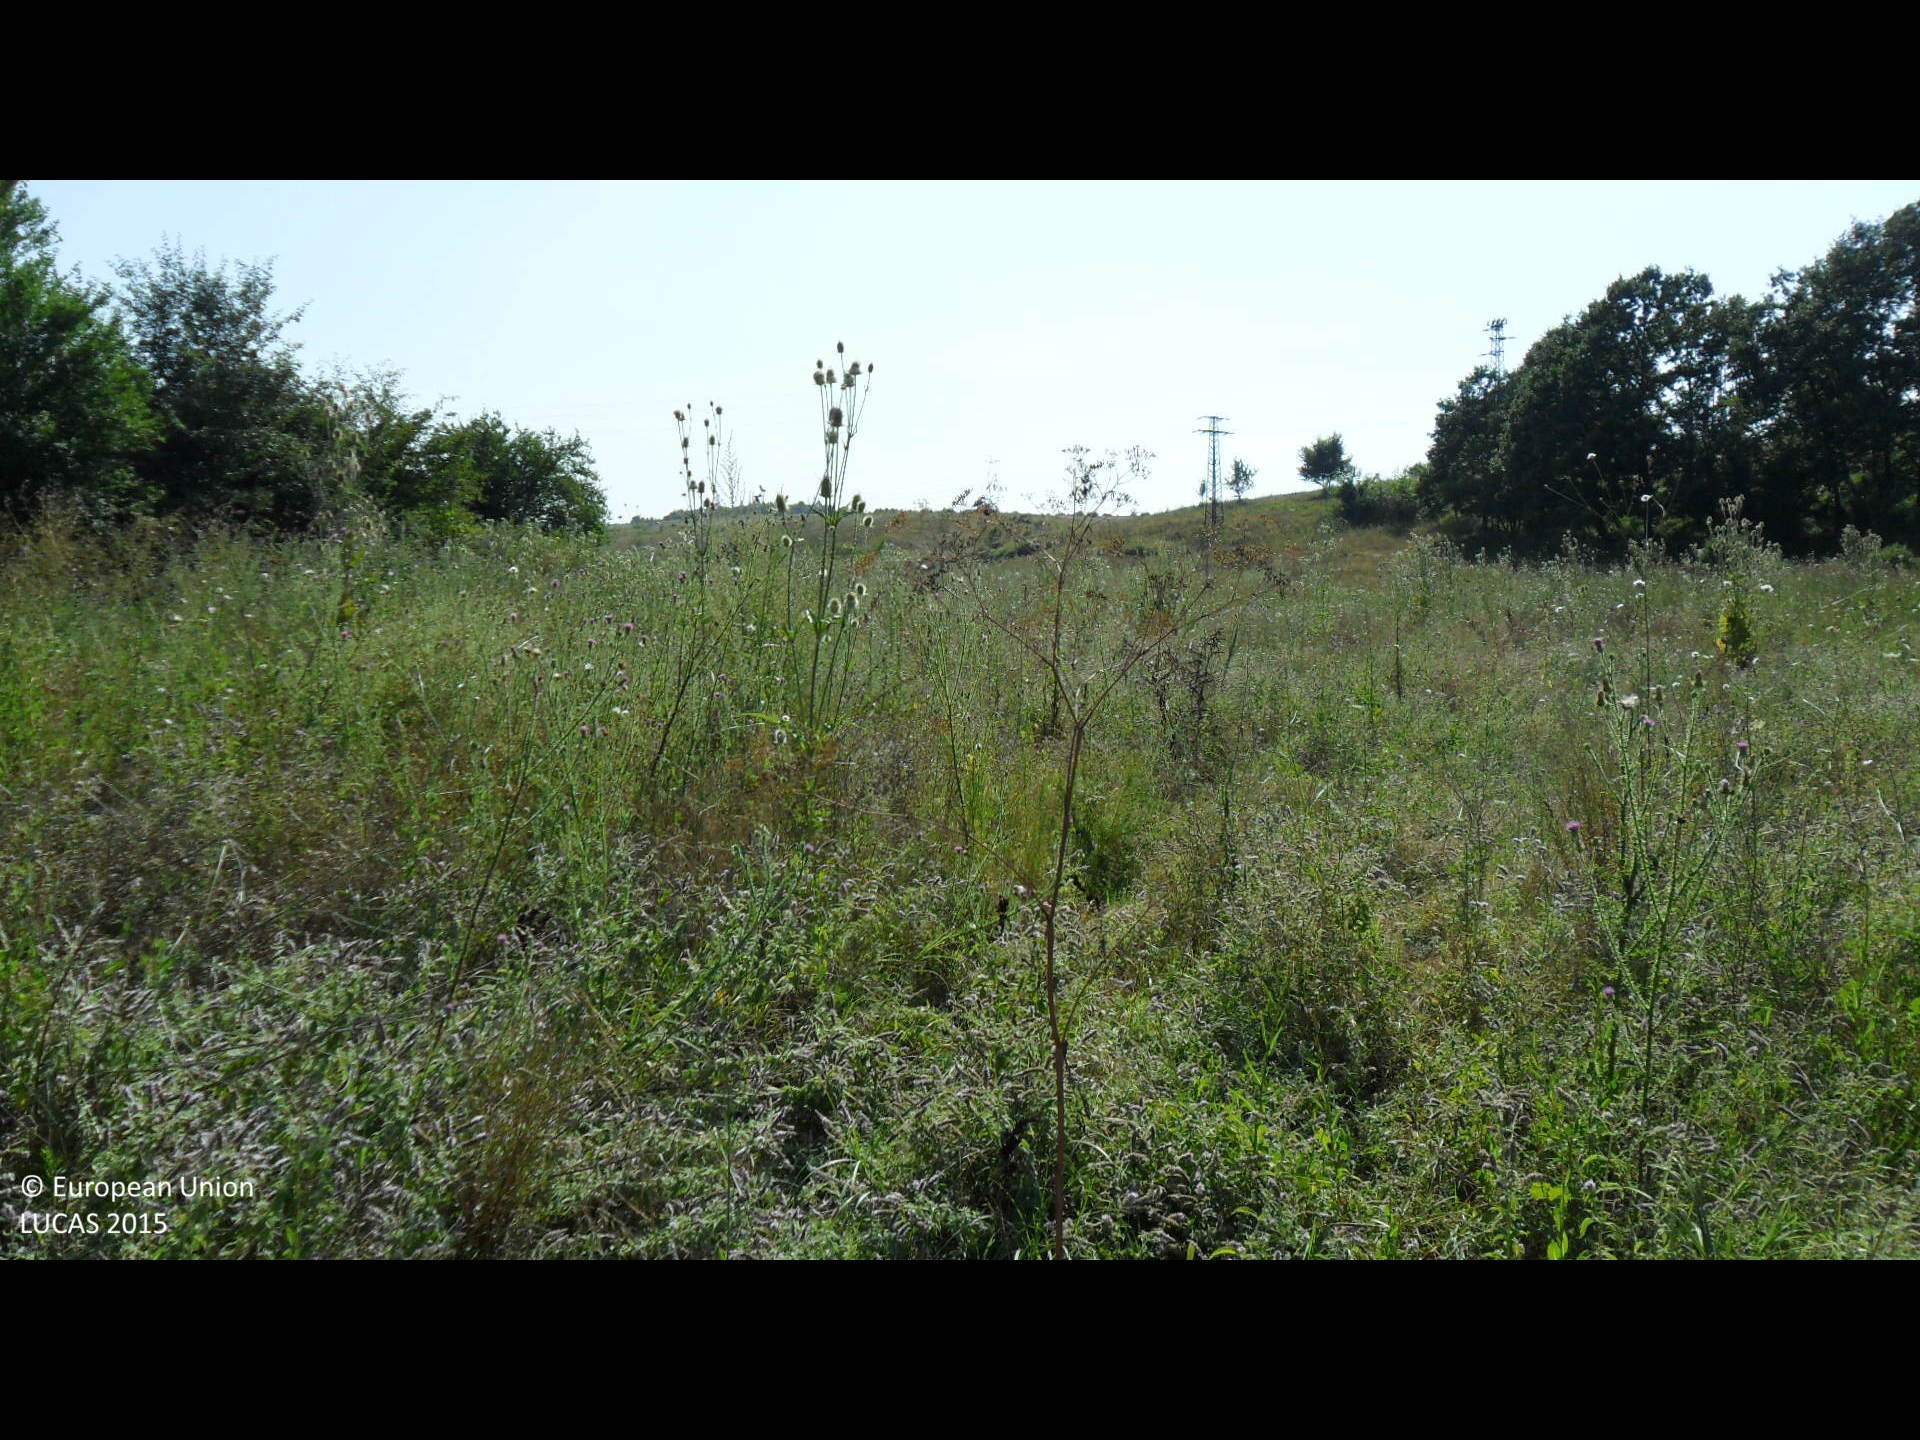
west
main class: Grassland
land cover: Grassland without tree/shrub cover
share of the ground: > 75 %
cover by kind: herbaceous plants 100 %
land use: Semi-natural and natural areas not in use
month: August
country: BG
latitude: 43.3049
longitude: 26.2078
